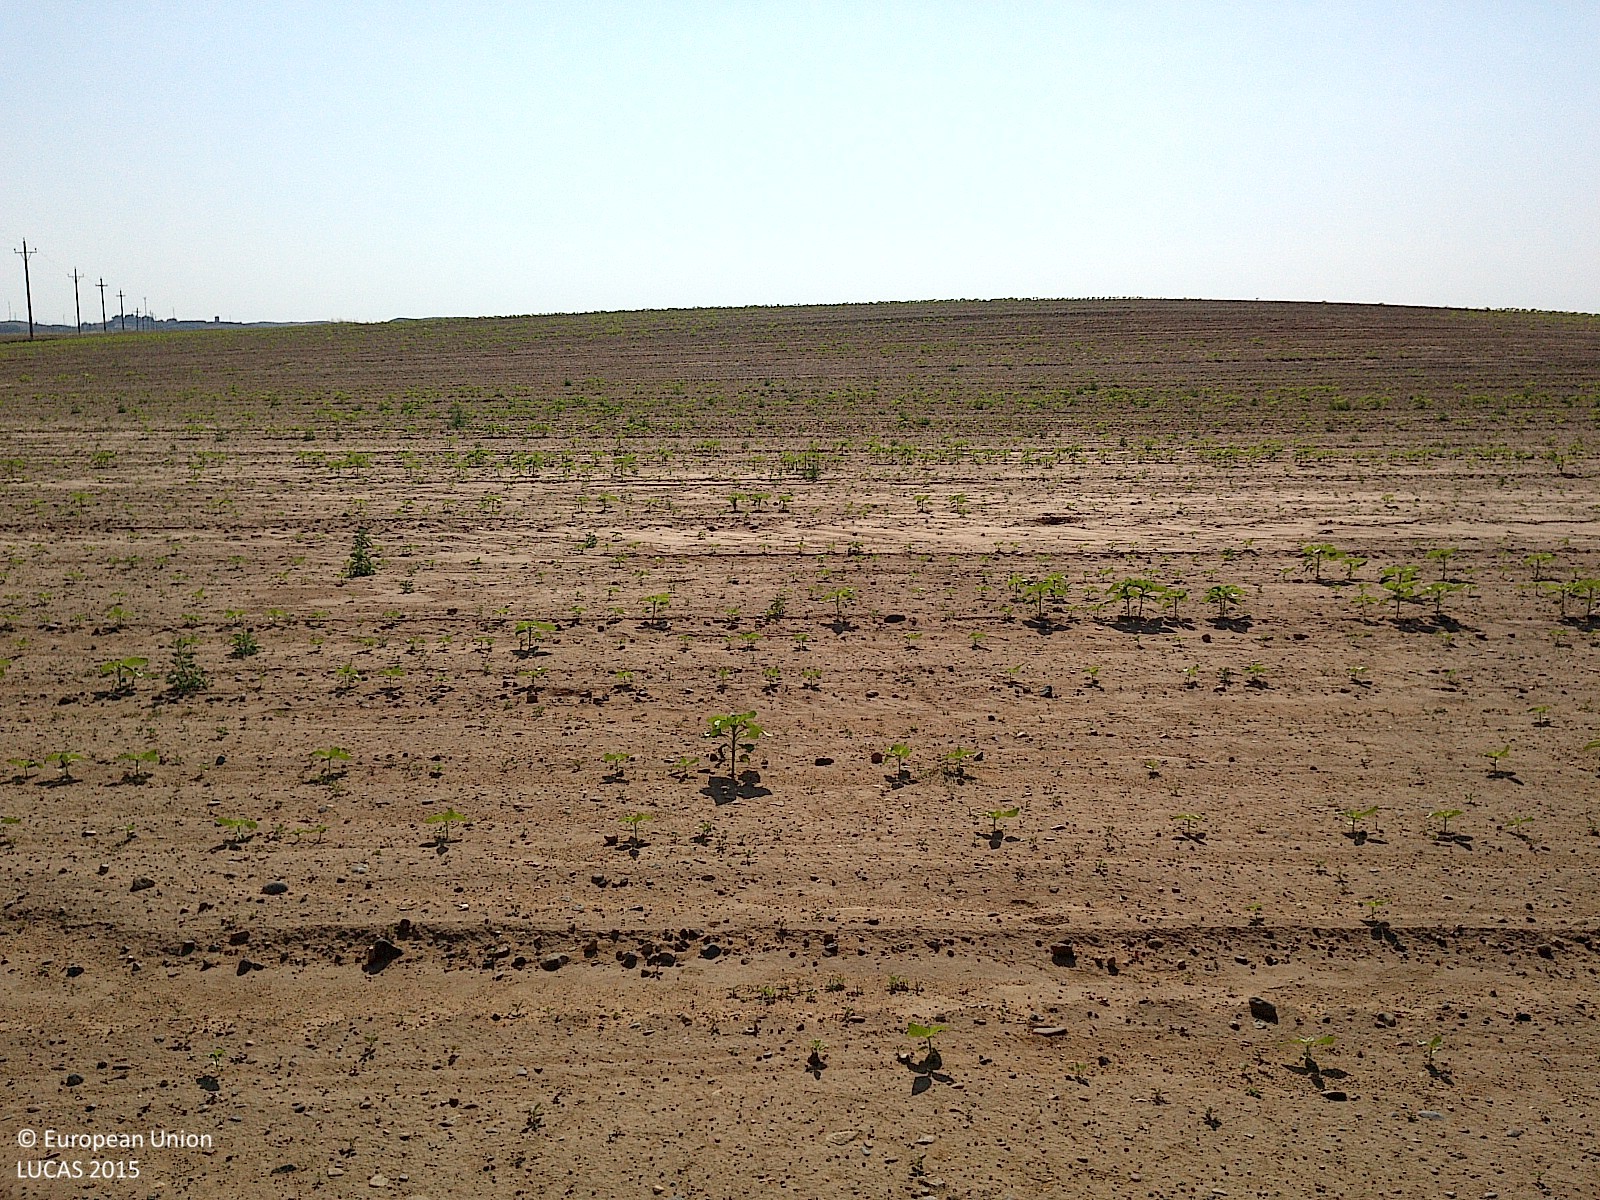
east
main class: Cropland
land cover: Sunflower
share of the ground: < 10 %
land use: Agriculture (excluding fallow land and kitchen gardens)
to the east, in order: Sunflower; Common wheat
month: June
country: ES
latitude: 41.6139
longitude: -2.2626
